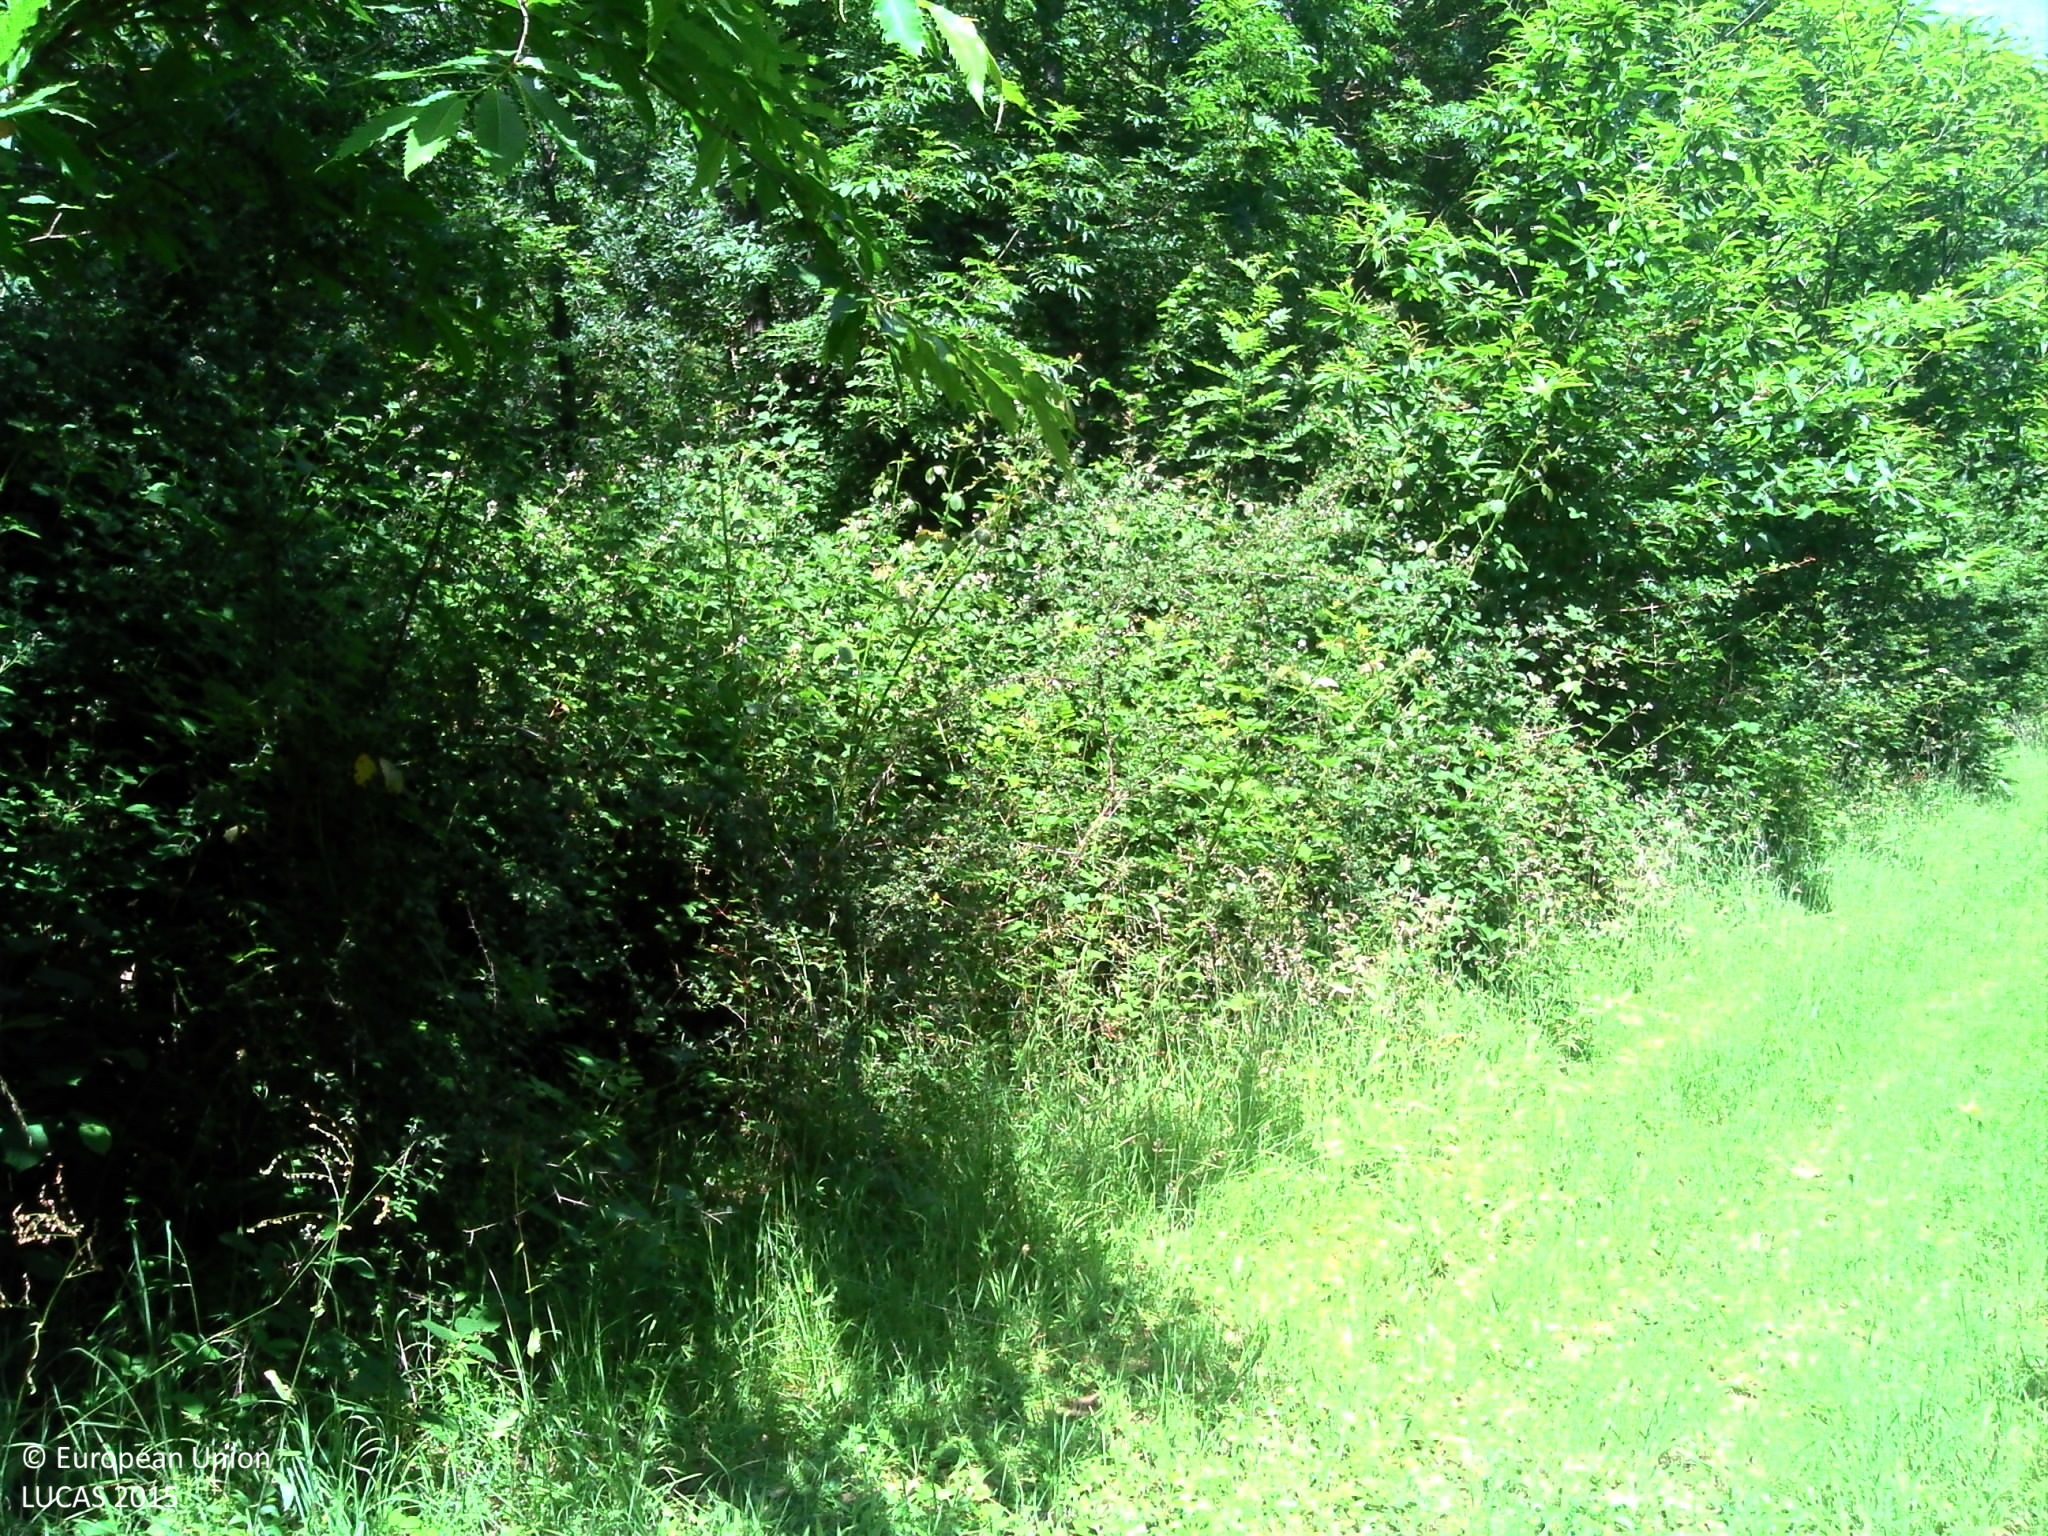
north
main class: Woodland
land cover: Broadleaved woodland
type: mesophytic deciduous forest
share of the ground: > 75 %
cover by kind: broadleaved forest trees 95 %, lichens and mosses 5 %
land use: Forestry
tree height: > 5 m
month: June
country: FR
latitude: 48.5938
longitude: 0.1141
